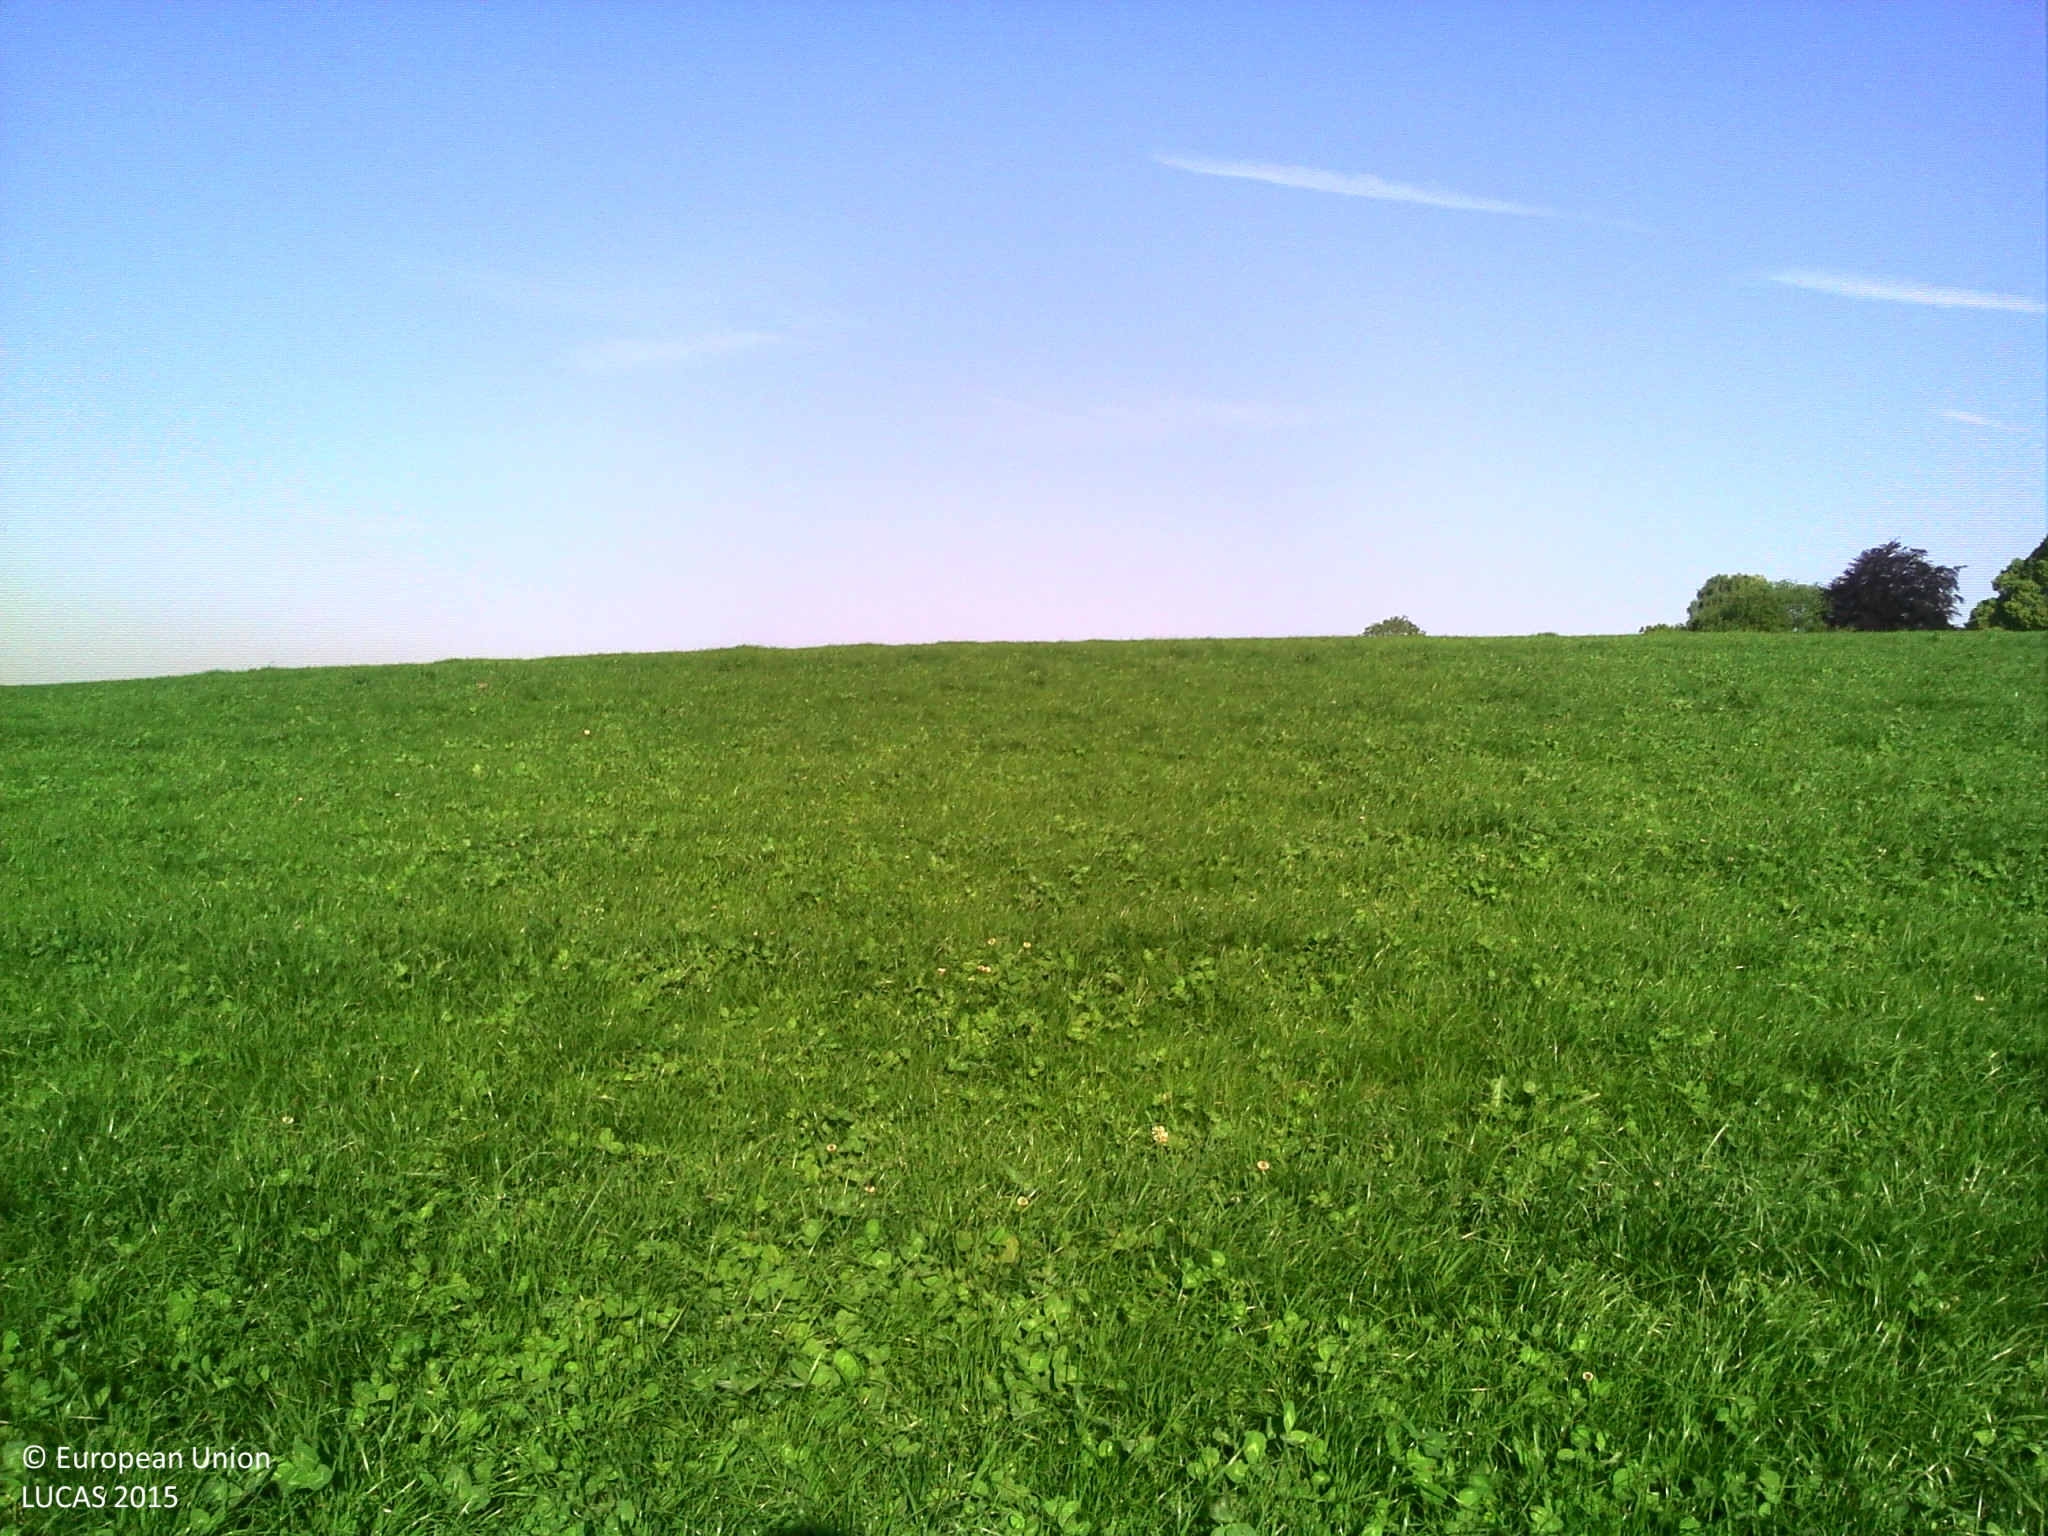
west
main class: Grassland
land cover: Grassland without tree/shrub cover
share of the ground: > 75 %
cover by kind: herbaceous plants 100 %
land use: Agriculture (excluding fallow land and kitchen gardens)
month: June
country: BE
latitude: 50.5151
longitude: 5.6407
